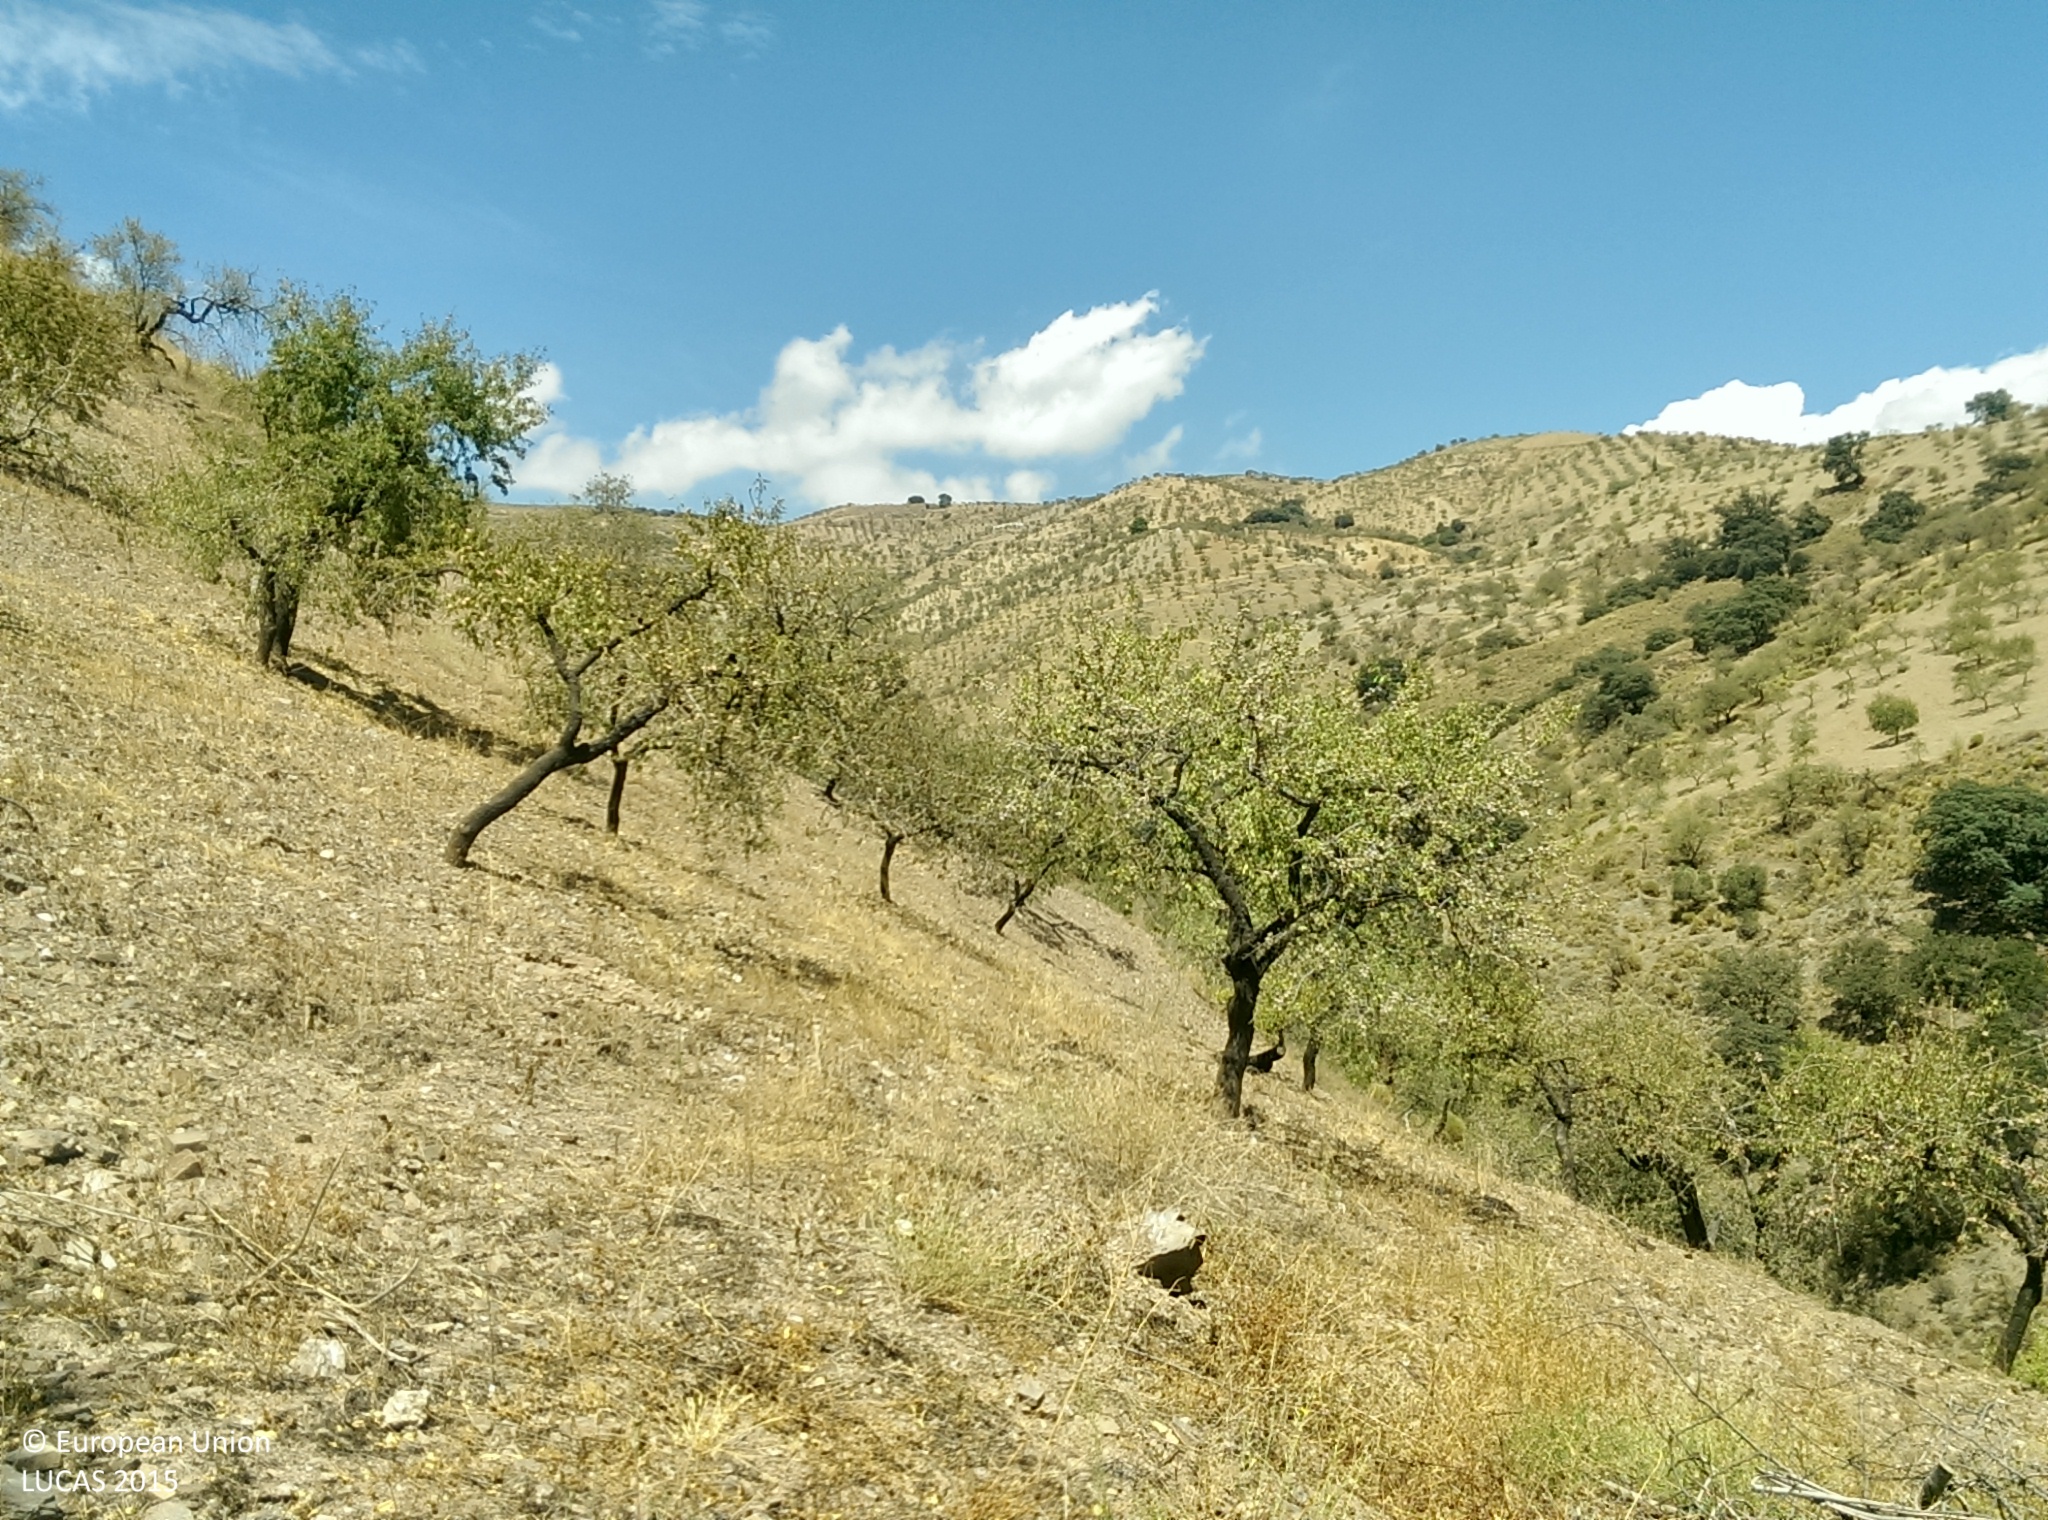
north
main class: Cropland
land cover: Nuts trees
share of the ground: 25 - 50 %
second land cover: Other bare soil
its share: > 75 %
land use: Agriculture (excluding fallow land and kitchen gardens)
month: August
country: ES
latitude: 36.8621
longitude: -3.1827
